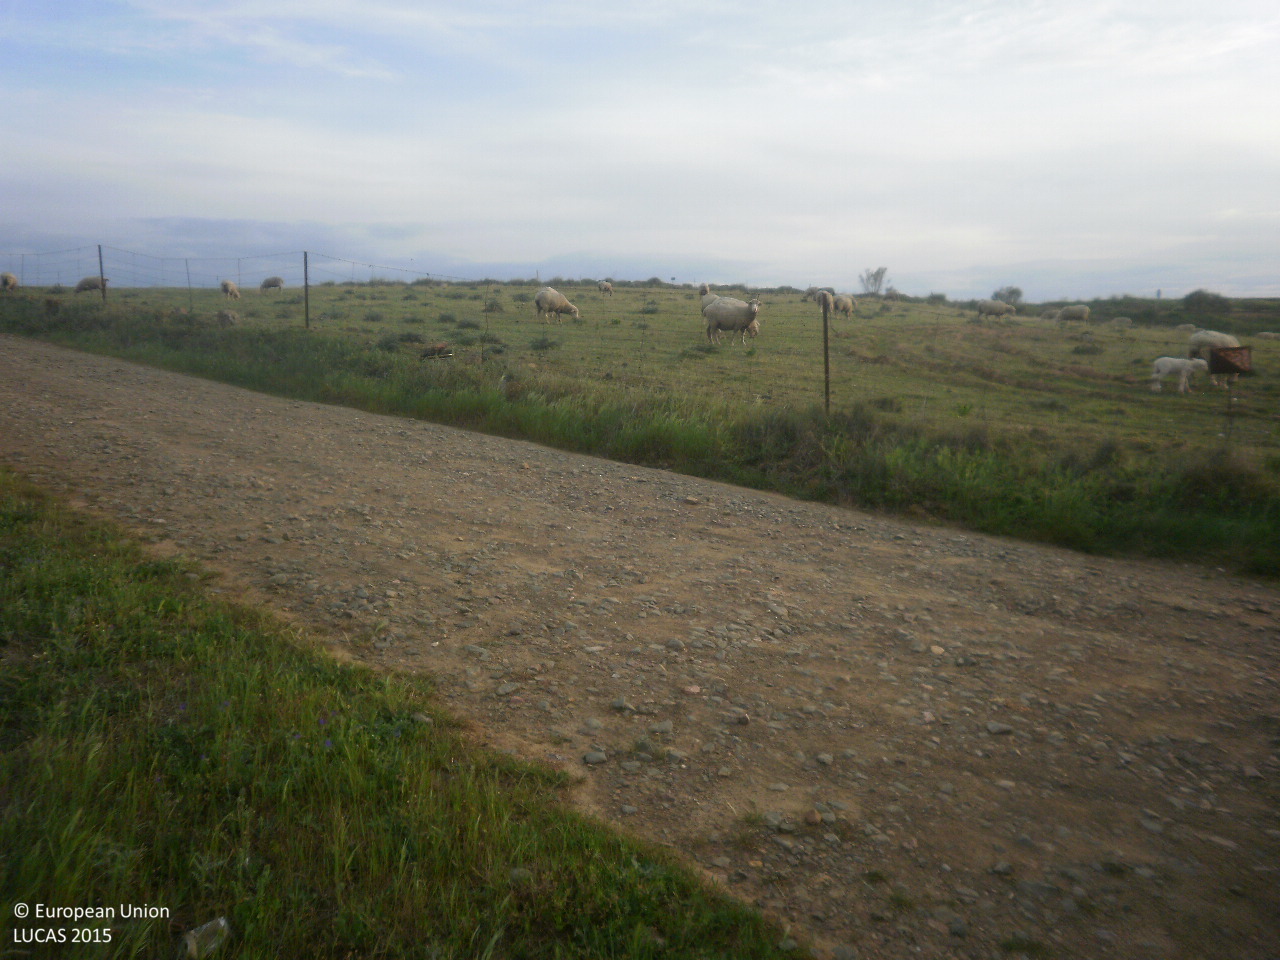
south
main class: Grassland
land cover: Grassland without tree/shrub cover
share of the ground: > 75 %
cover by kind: herbaceous plants 100 %
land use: Agriculture (excluding fallow land and kitchen gardens)
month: April
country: ES
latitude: 39.0831
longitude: -5.2660
